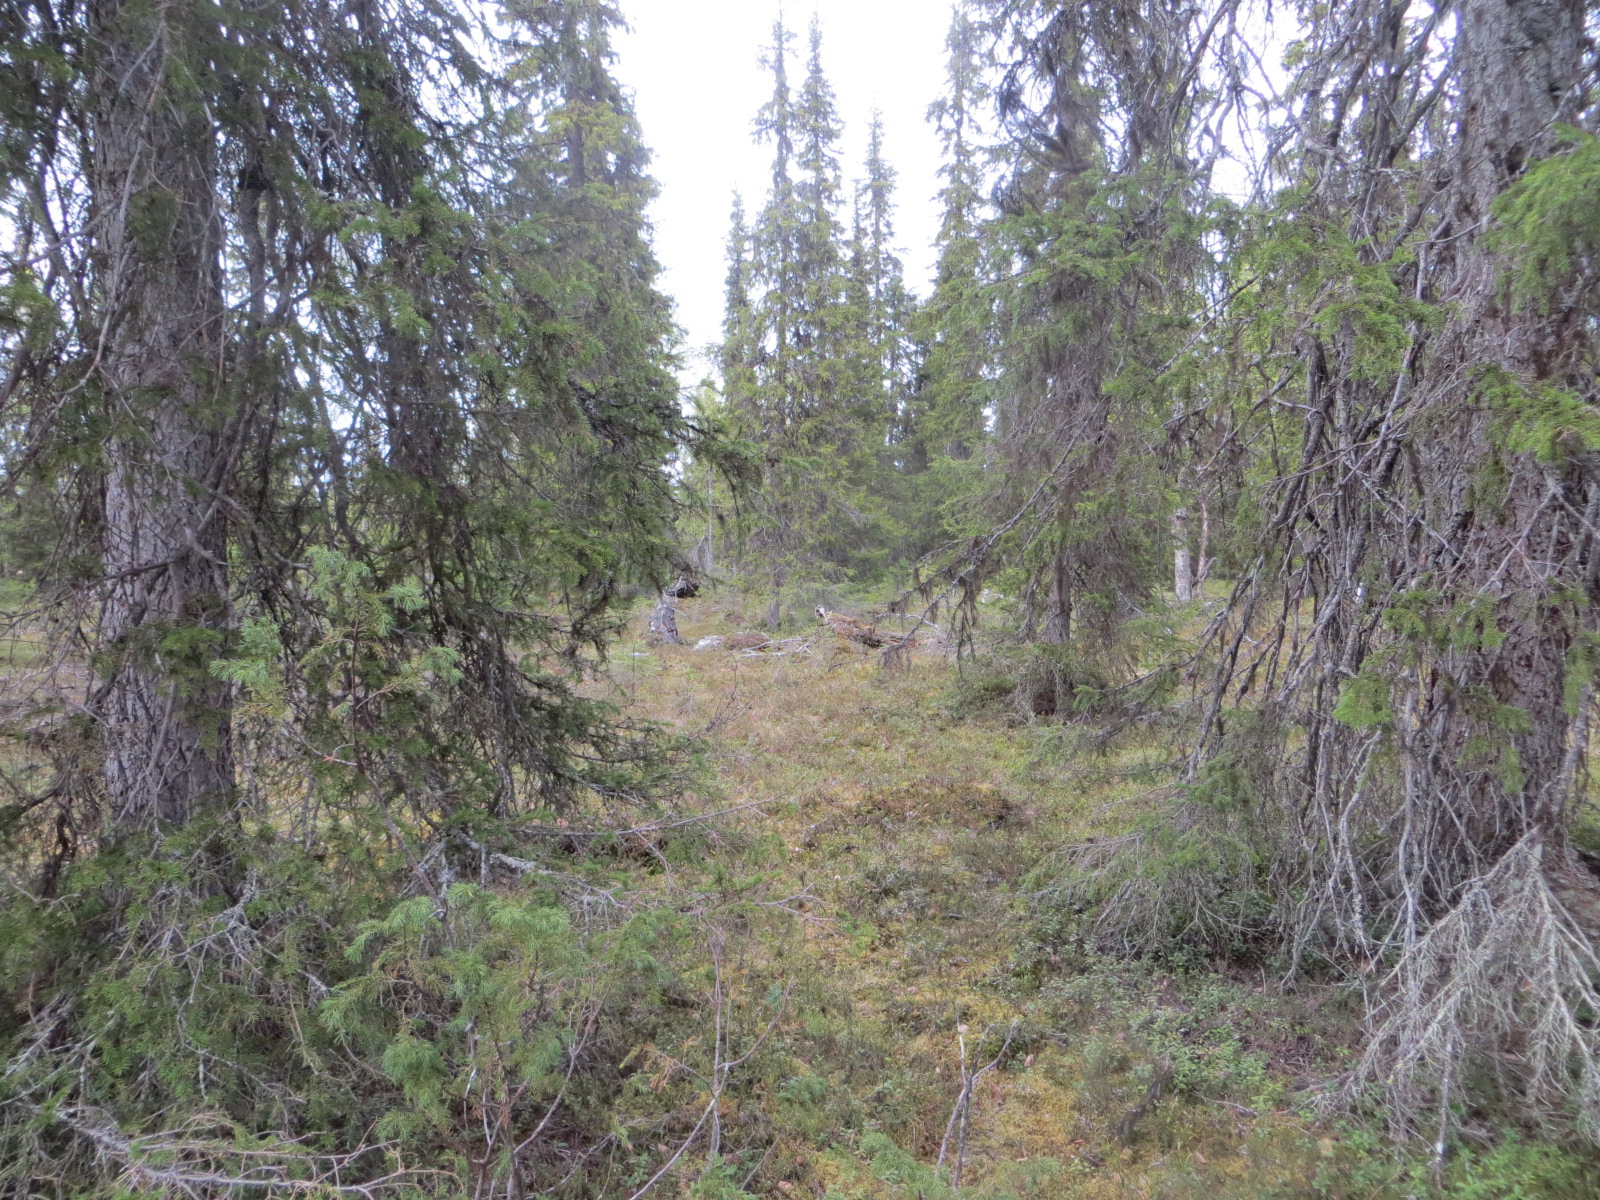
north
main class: Woodland
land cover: Spruce dominated mixed woodland
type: boreal forest
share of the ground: 50 - 75 %
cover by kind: coniferous forest trees 50 %, shrubs 25 %, broadleaved forest trees 20 %, lichens and mosses 5 %
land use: Semi-natural and natural areas not in use
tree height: > 5 m
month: June
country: FI
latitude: 67.9613
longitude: 26.1758
